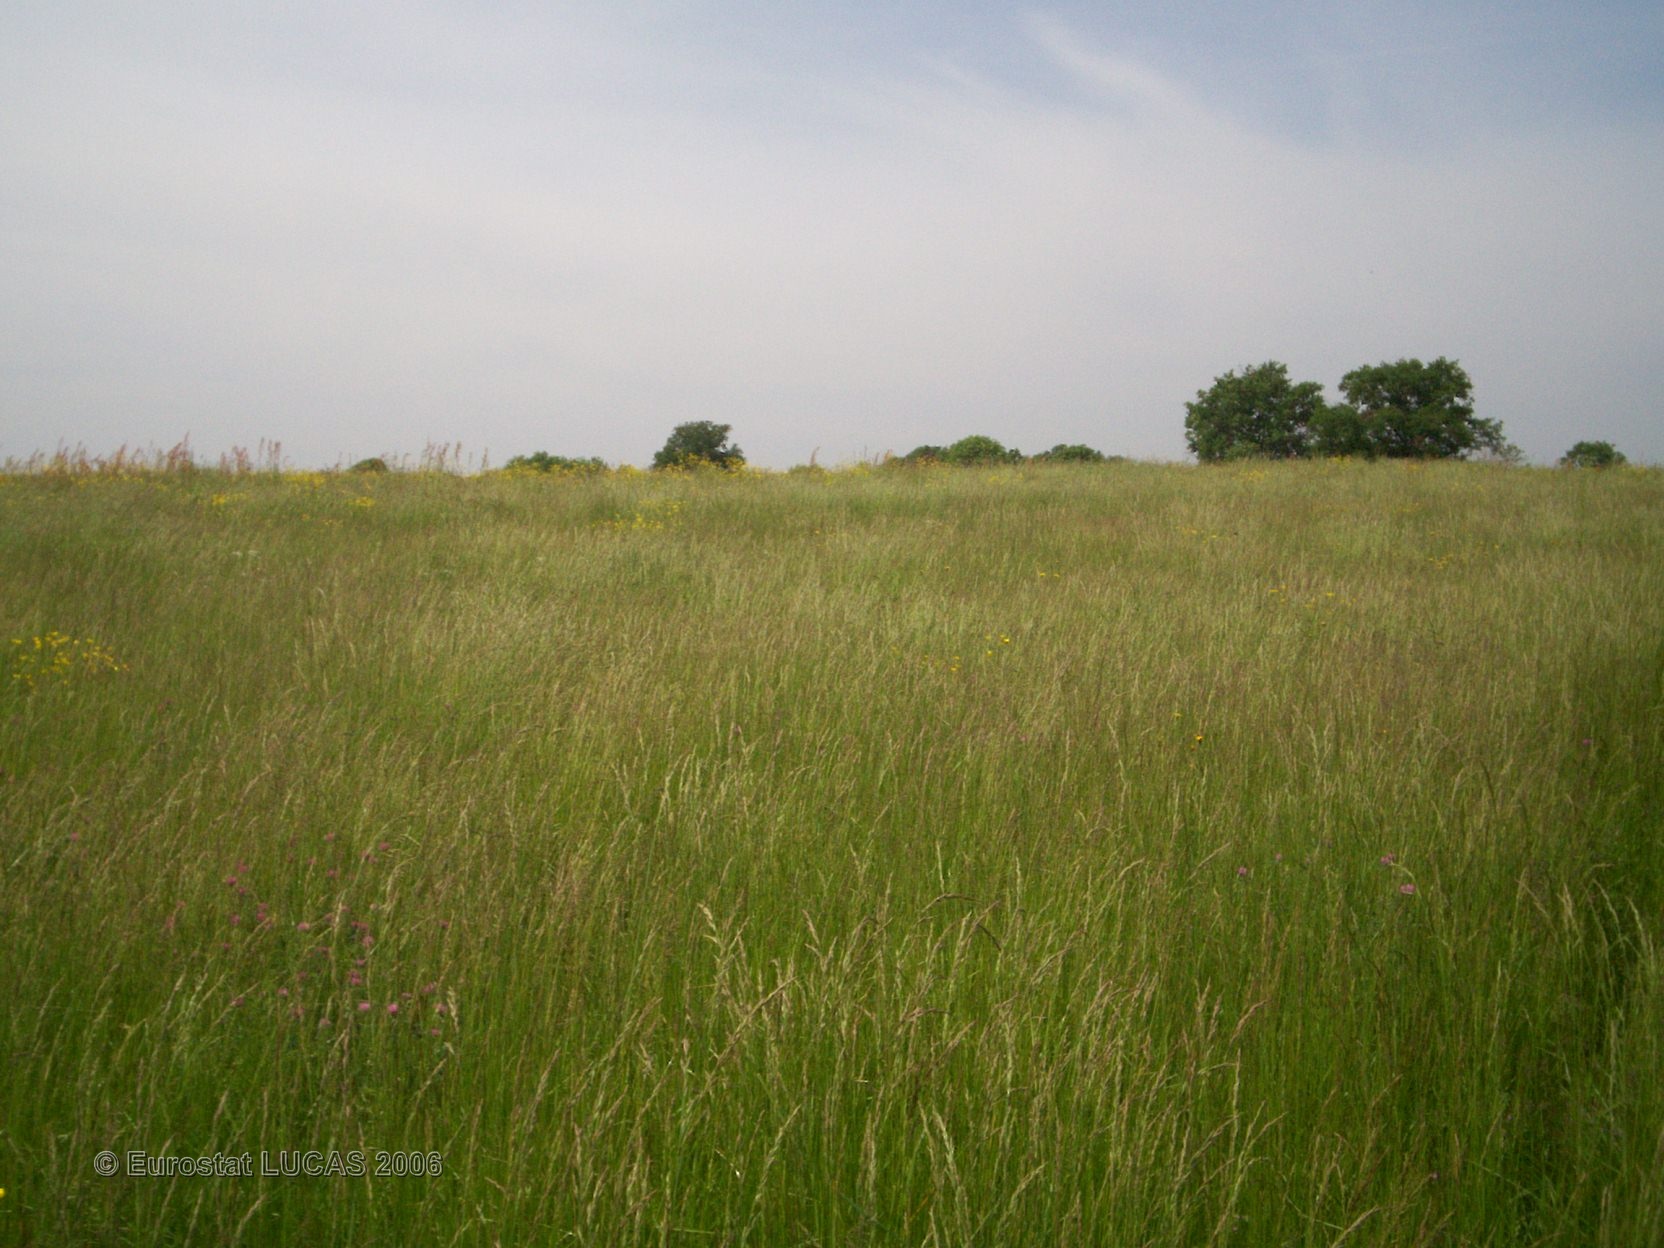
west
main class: Grassland
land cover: Grassland without tree/shrub cover
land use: Agriculture (excluding fallow land and kitchen gardens)
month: May
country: FR
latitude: 46.6019
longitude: -0.8002
